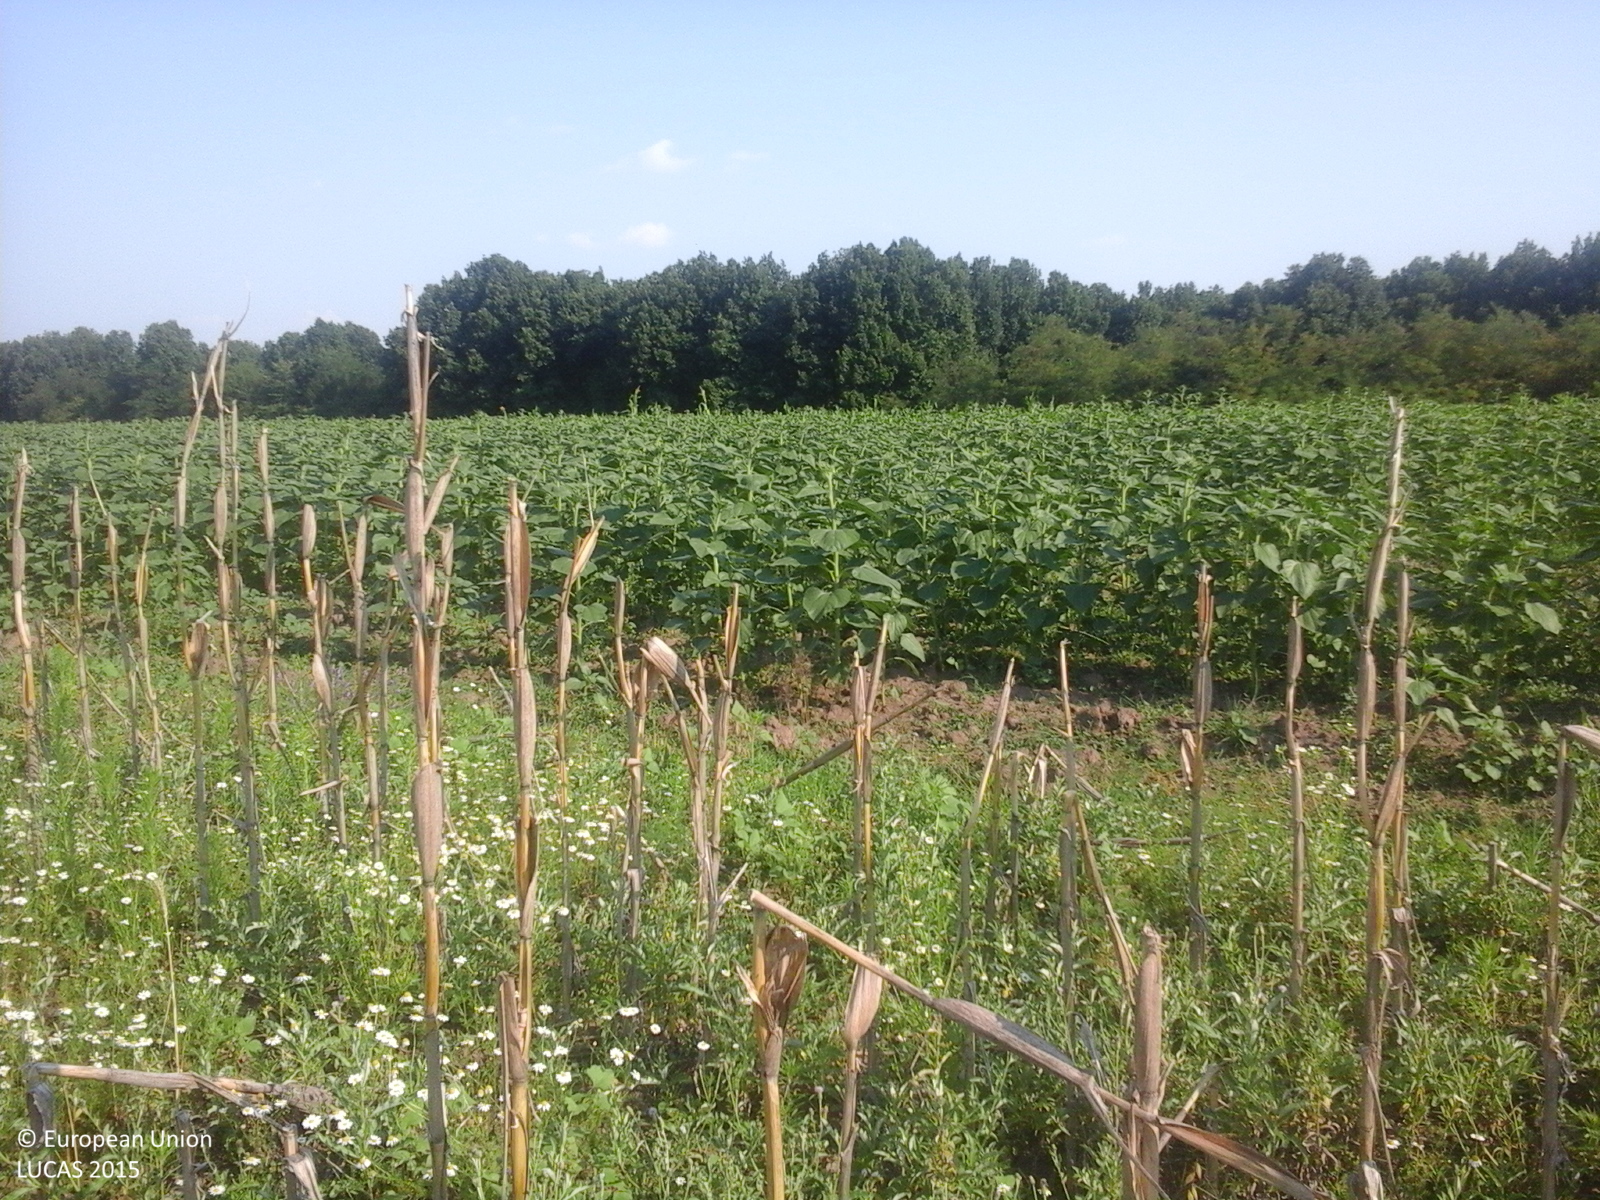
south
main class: Grassland
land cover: Spontaneously vegetated surfaces
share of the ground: > 75 %
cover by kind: herbaceous plants 100 %
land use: Fallow land
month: July
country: RO
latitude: 44.5329
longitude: 24.7621
